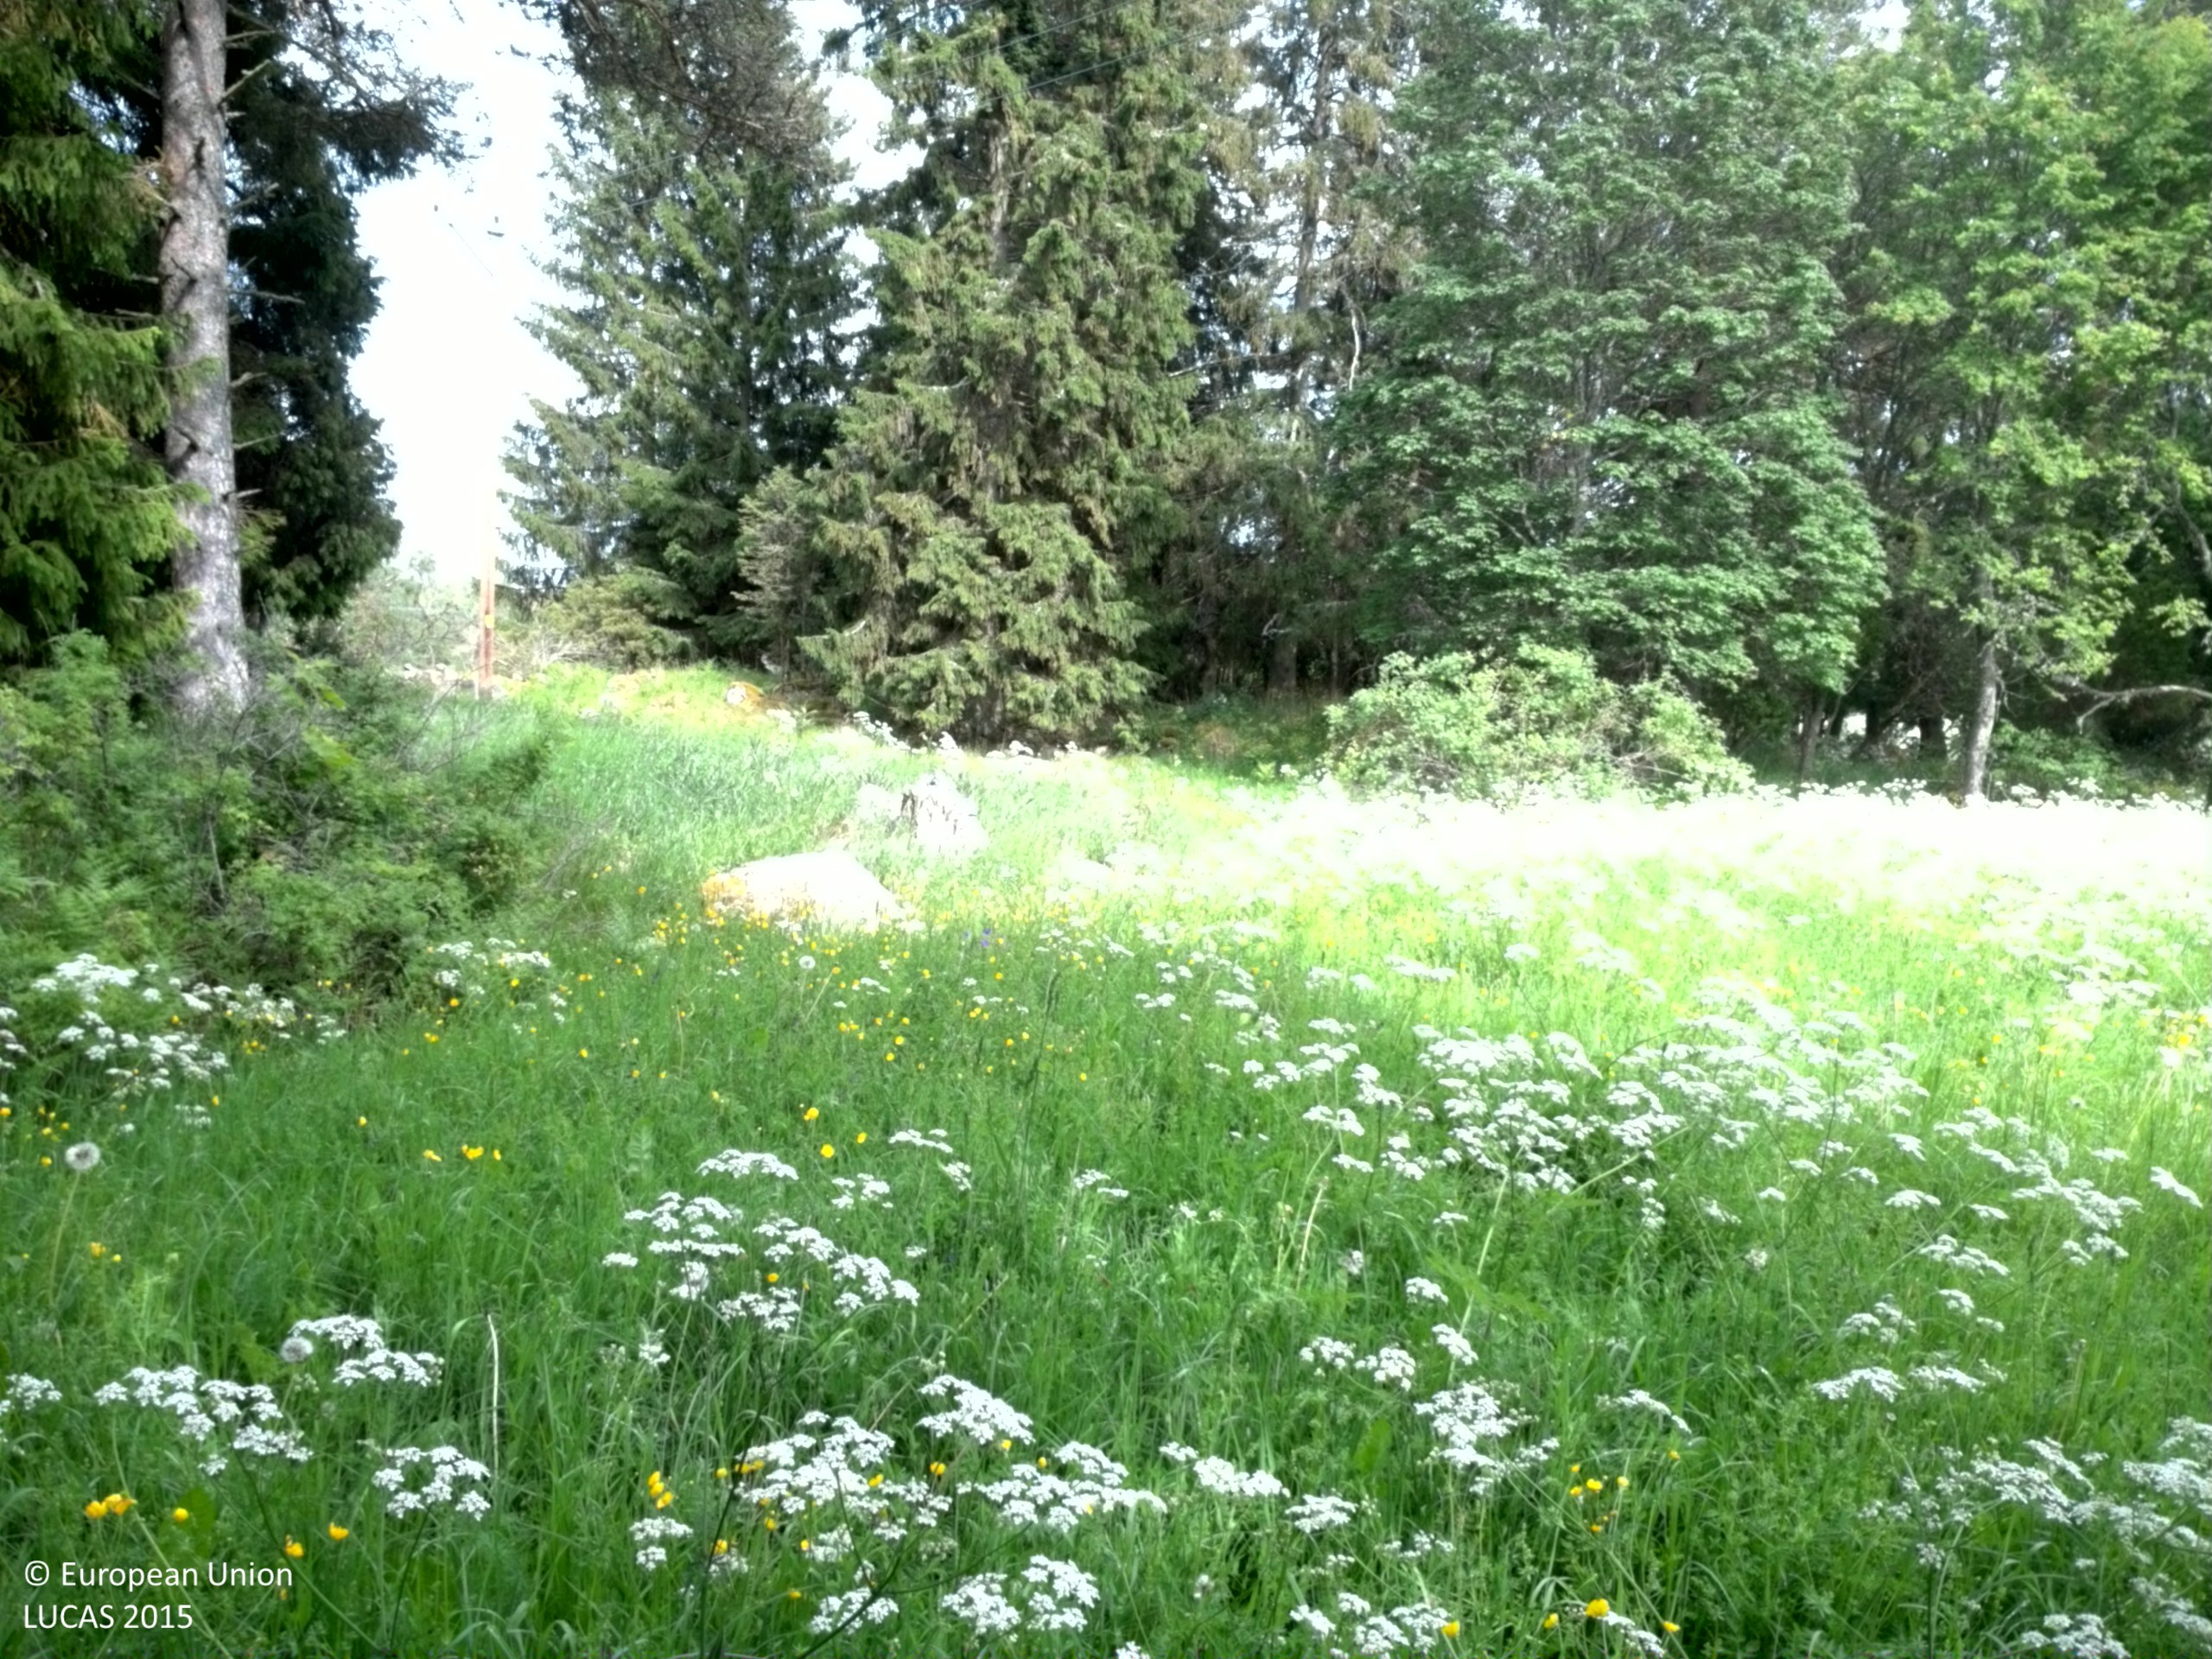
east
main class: Grassland
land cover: Grassland with sparse tree/shrub cover
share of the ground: > 75 %
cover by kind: herbaceous plants 90 %, broadleaved forest trees 5 %, shrubs 5 %
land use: Semi-natural and natural areas not in use
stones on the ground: < 10 %
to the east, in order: Grassland with sparse tree/shrub cover; Electric lines; Spruce dominated coniferous woodland; Spruce dominated mixed woodland; Grassland without tree/shrub cover; Broadleaved woodland; Grassland with sparse tree/shrub cover; Ditches and canals; Grassland with sparse tree/shrub cover; Fences; Grassland with sparse tree/shrub cover; Electric lines; Grassland with sparse tree/shrub cover; Grassland without tree/shrub cover; Fences; Broadleaved woodland; Rivers and streams; Grassland without tree/shrub cover; Fences; Temporary grasslands; Electric lines; Temporary grasslands
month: June
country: SE
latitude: 60.3506
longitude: 17.6942
